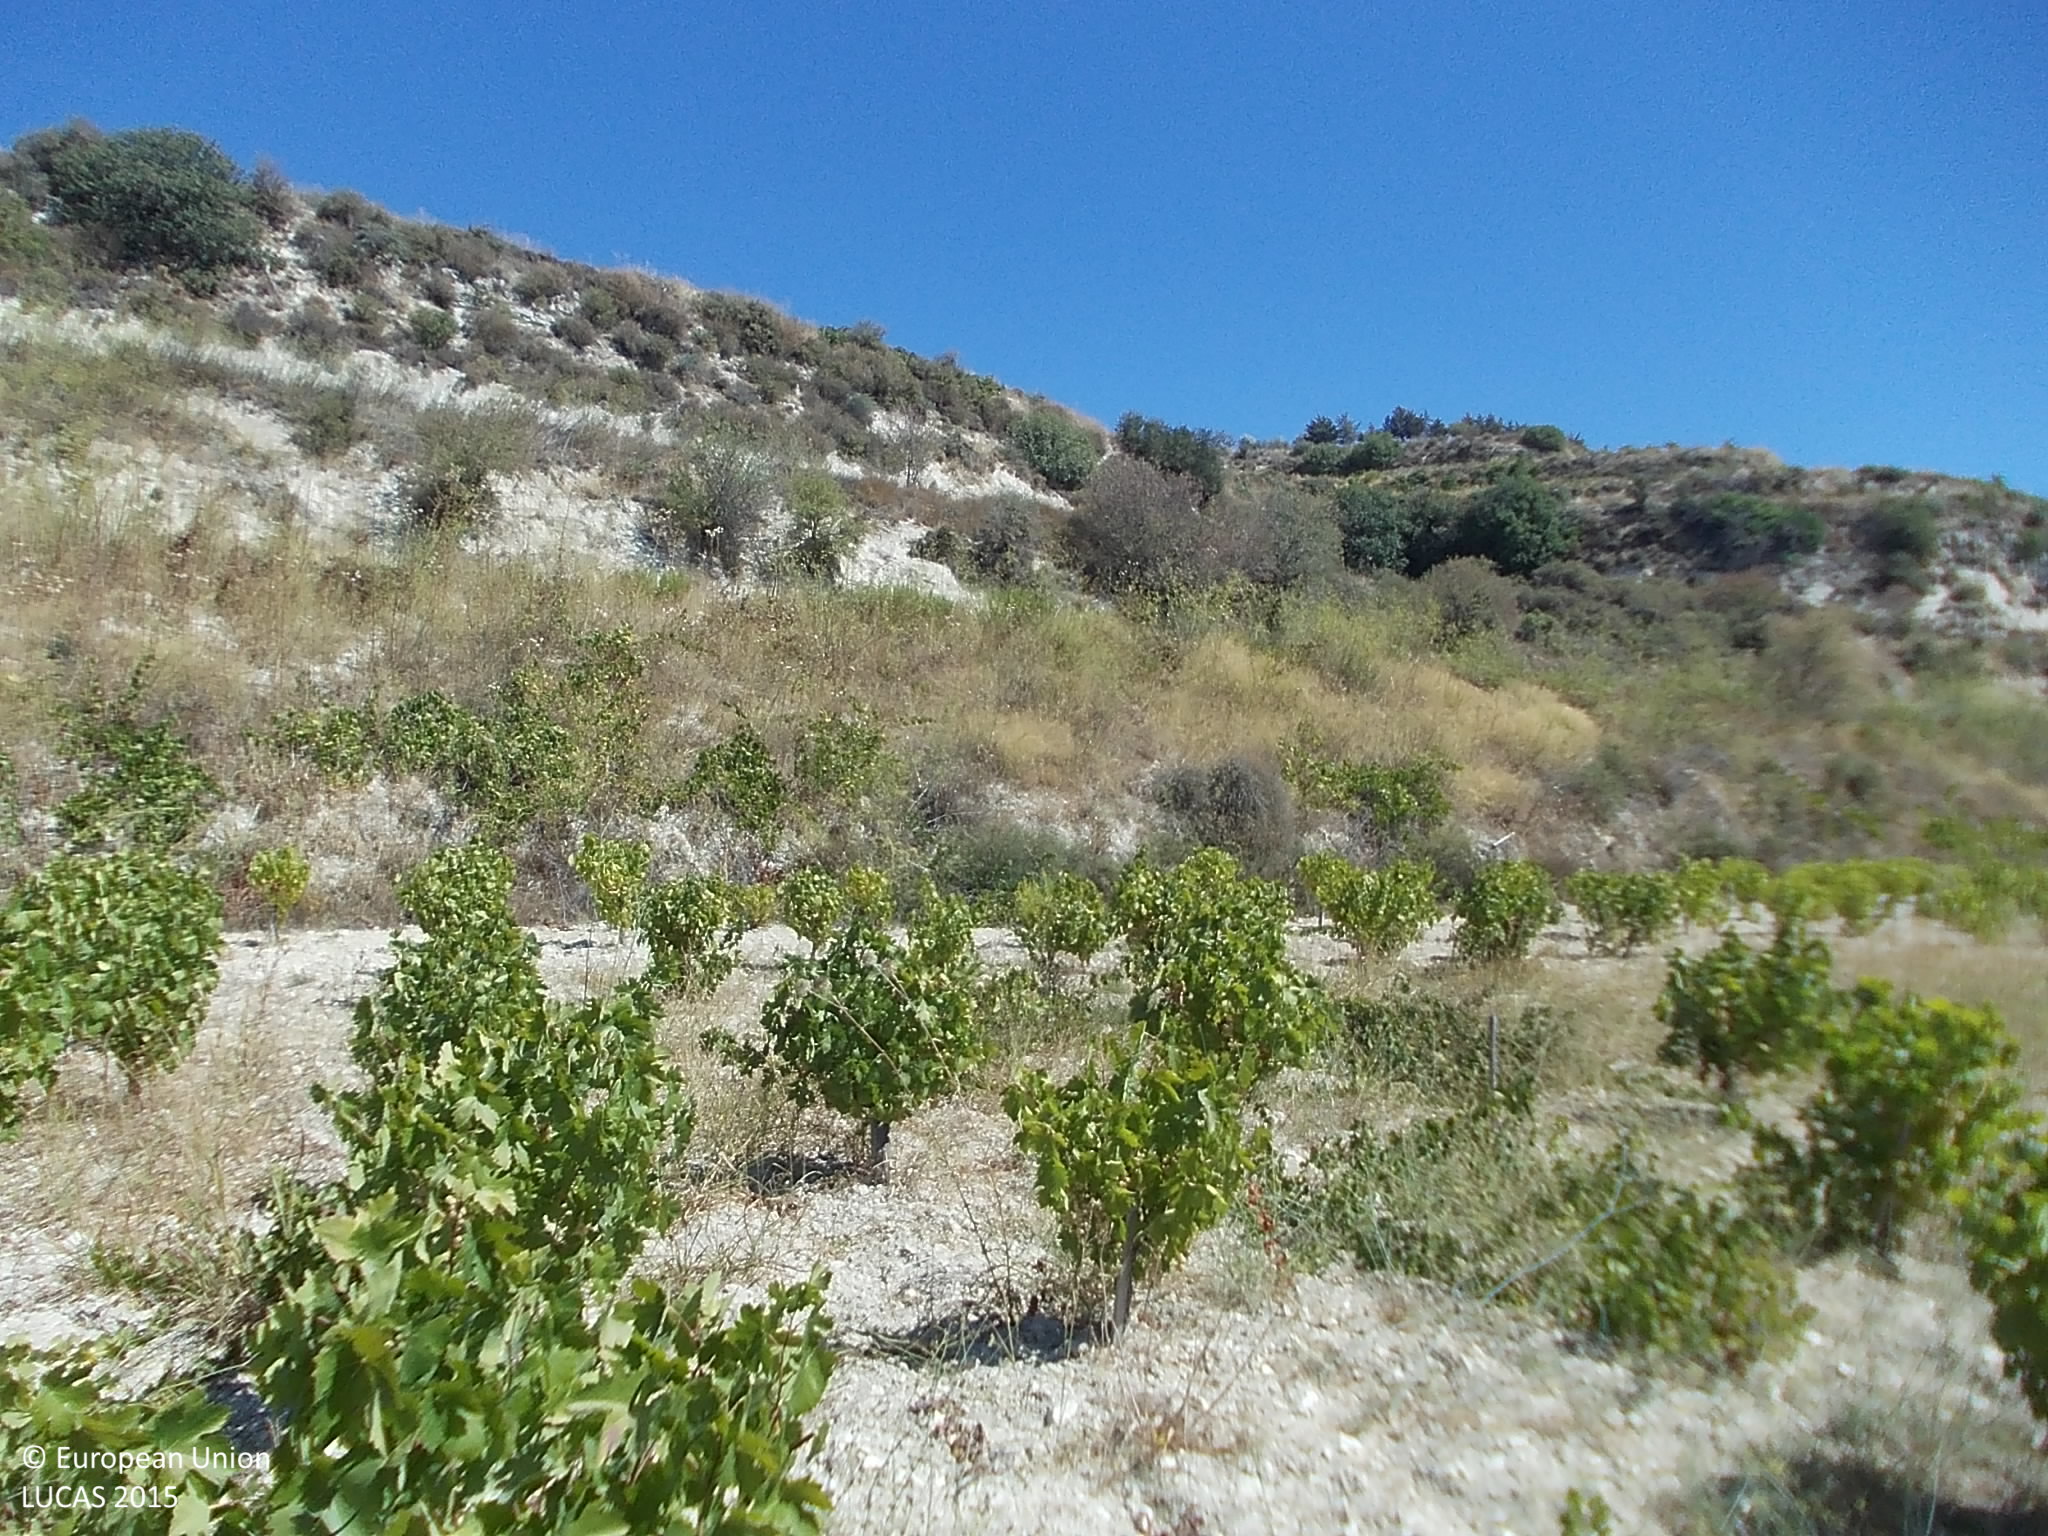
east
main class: Cropland
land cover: Vineyards
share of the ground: 25 - 50 %
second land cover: Other bare soil
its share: > 75 %
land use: Agriculture (excluding fallow land and kitchen gardens)
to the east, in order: Vineyards; Other bare soil; Shrubland without tree cover; Vineyards; Shrubland without tree cover; Vineyards; Shrubland without tree cover; Vineyards; Shrubland without tree cover; Vineyards; Shrubland without tree cover; Vineyards; Shrubland without tree cover; Vineyards; Shrubland without tree cover; Vineyards
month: May
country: CY
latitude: 34.7905
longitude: 32.7928
